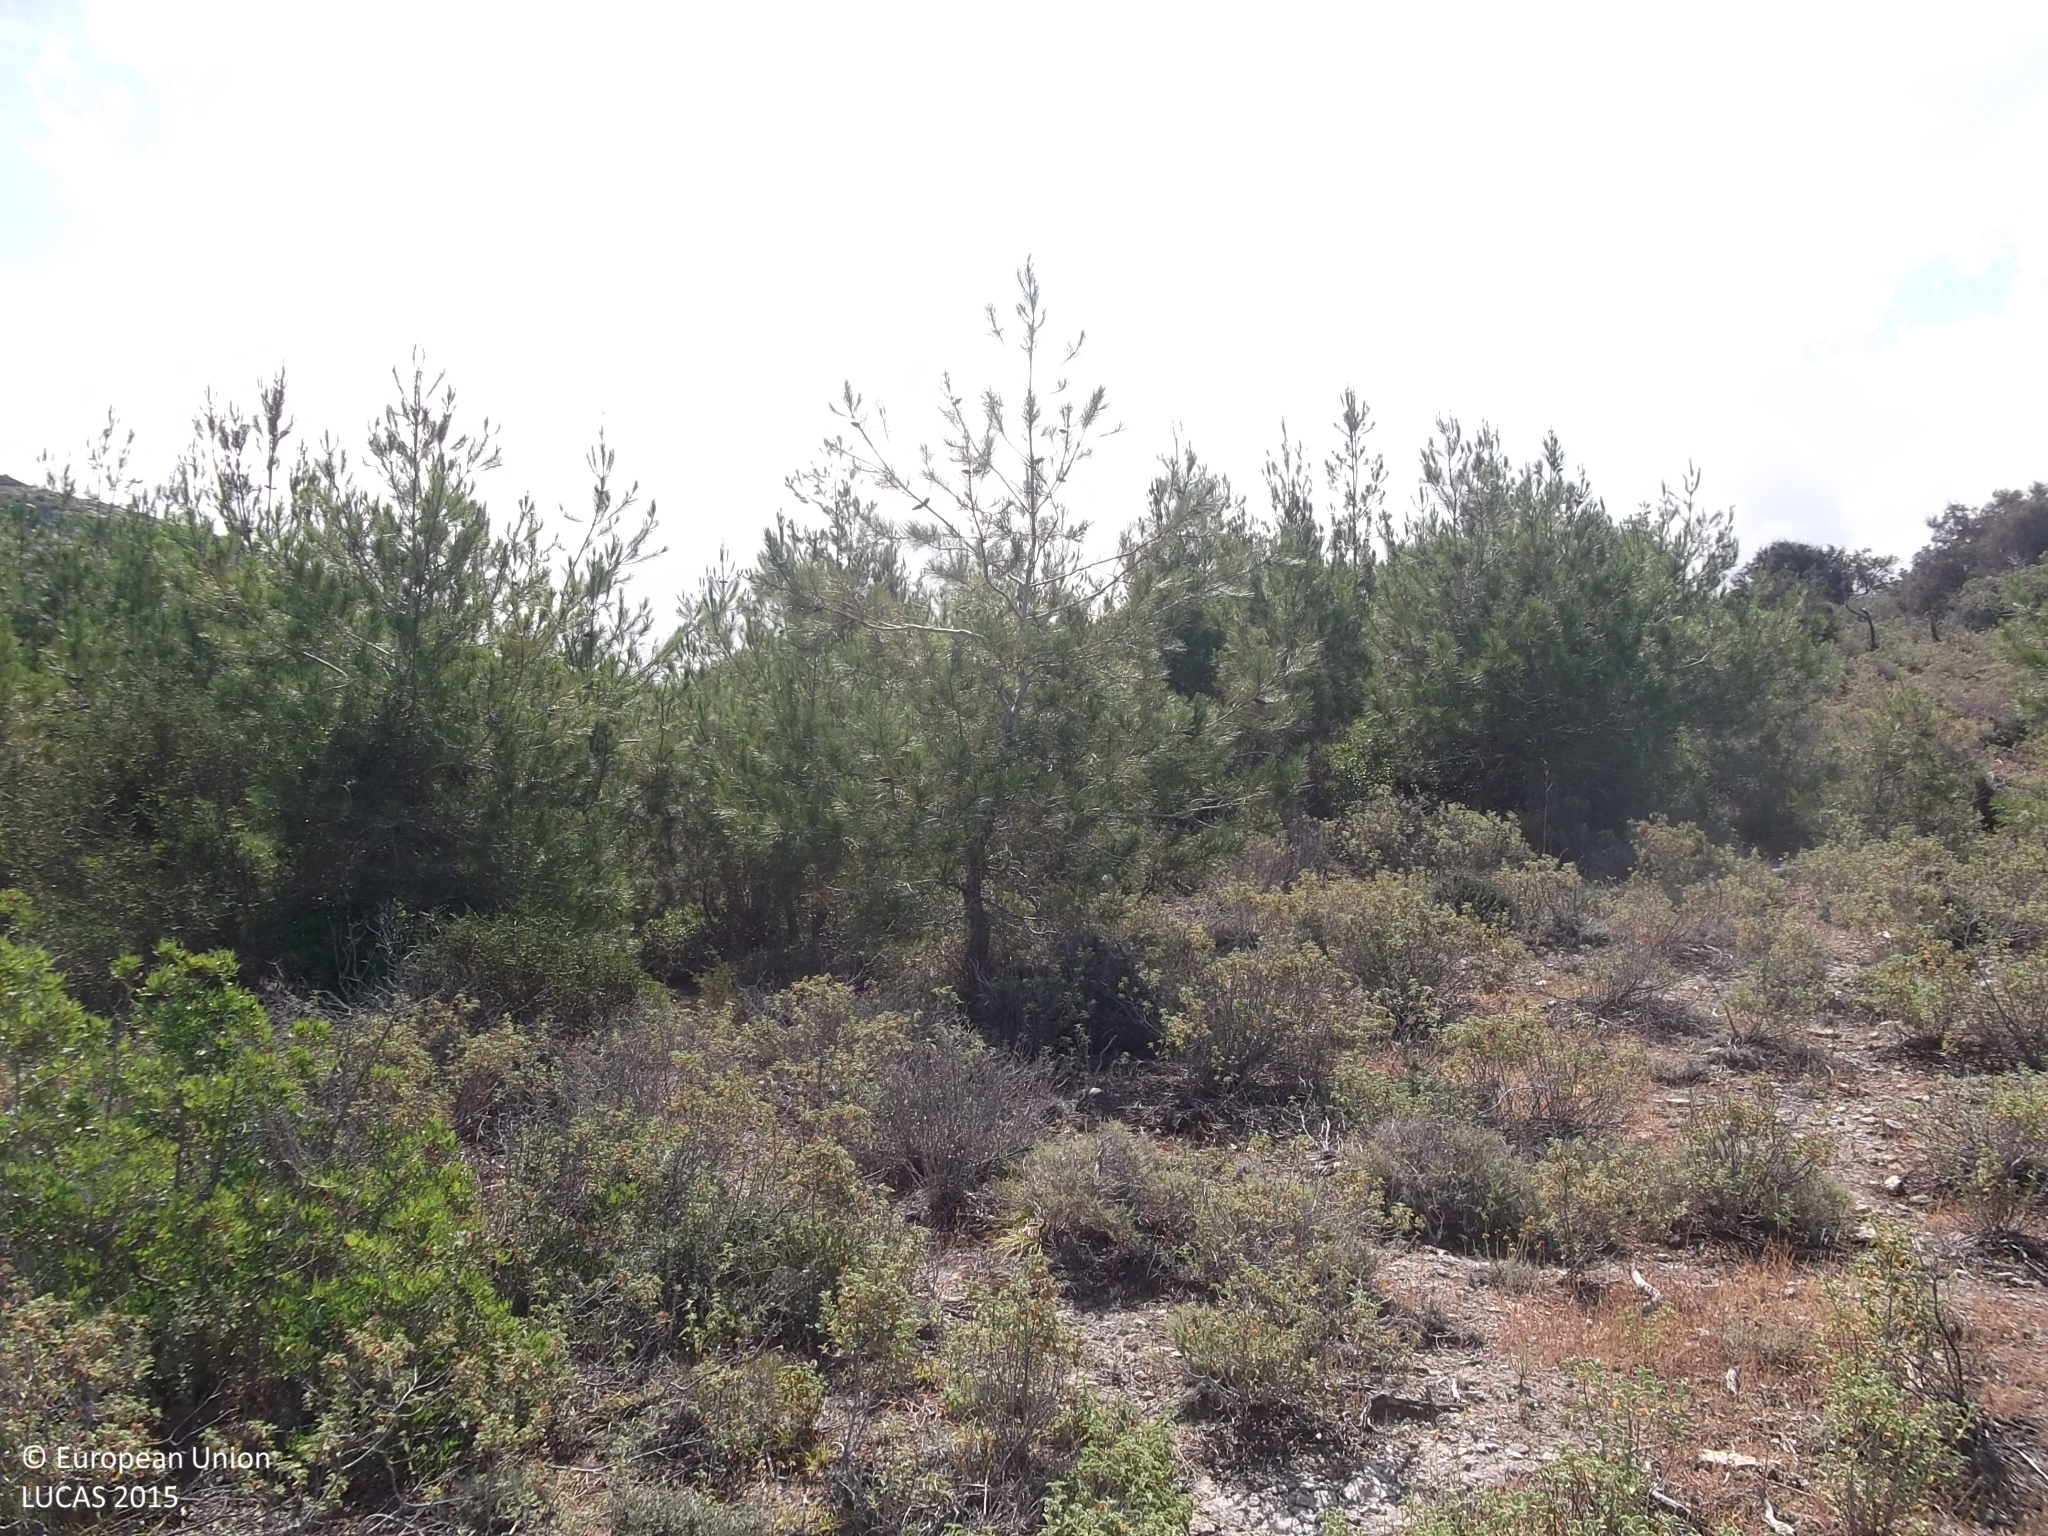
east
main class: Shrubland
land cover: Shrubland with sparse tree cover
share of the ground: > 75 %
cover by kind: shrubs 85 %, unconsolidated bare surface 10 %, broadleaved forest trees 5 %
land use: Agriculture (excluding fallow land and kitchen gardens)
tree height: < 5 m
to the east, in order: Shrubland with sparse tree cover; Pine dominated coniferous woodland; Shrubland with sparse tree cover; Rock outcrops; Shrubland without tree cover; Other coniferous woodland; Shrubland without tree cover; Rock outcrops; Shrubland without tree cover
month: May
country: CY
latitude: 35.0663
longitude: 32.2889
